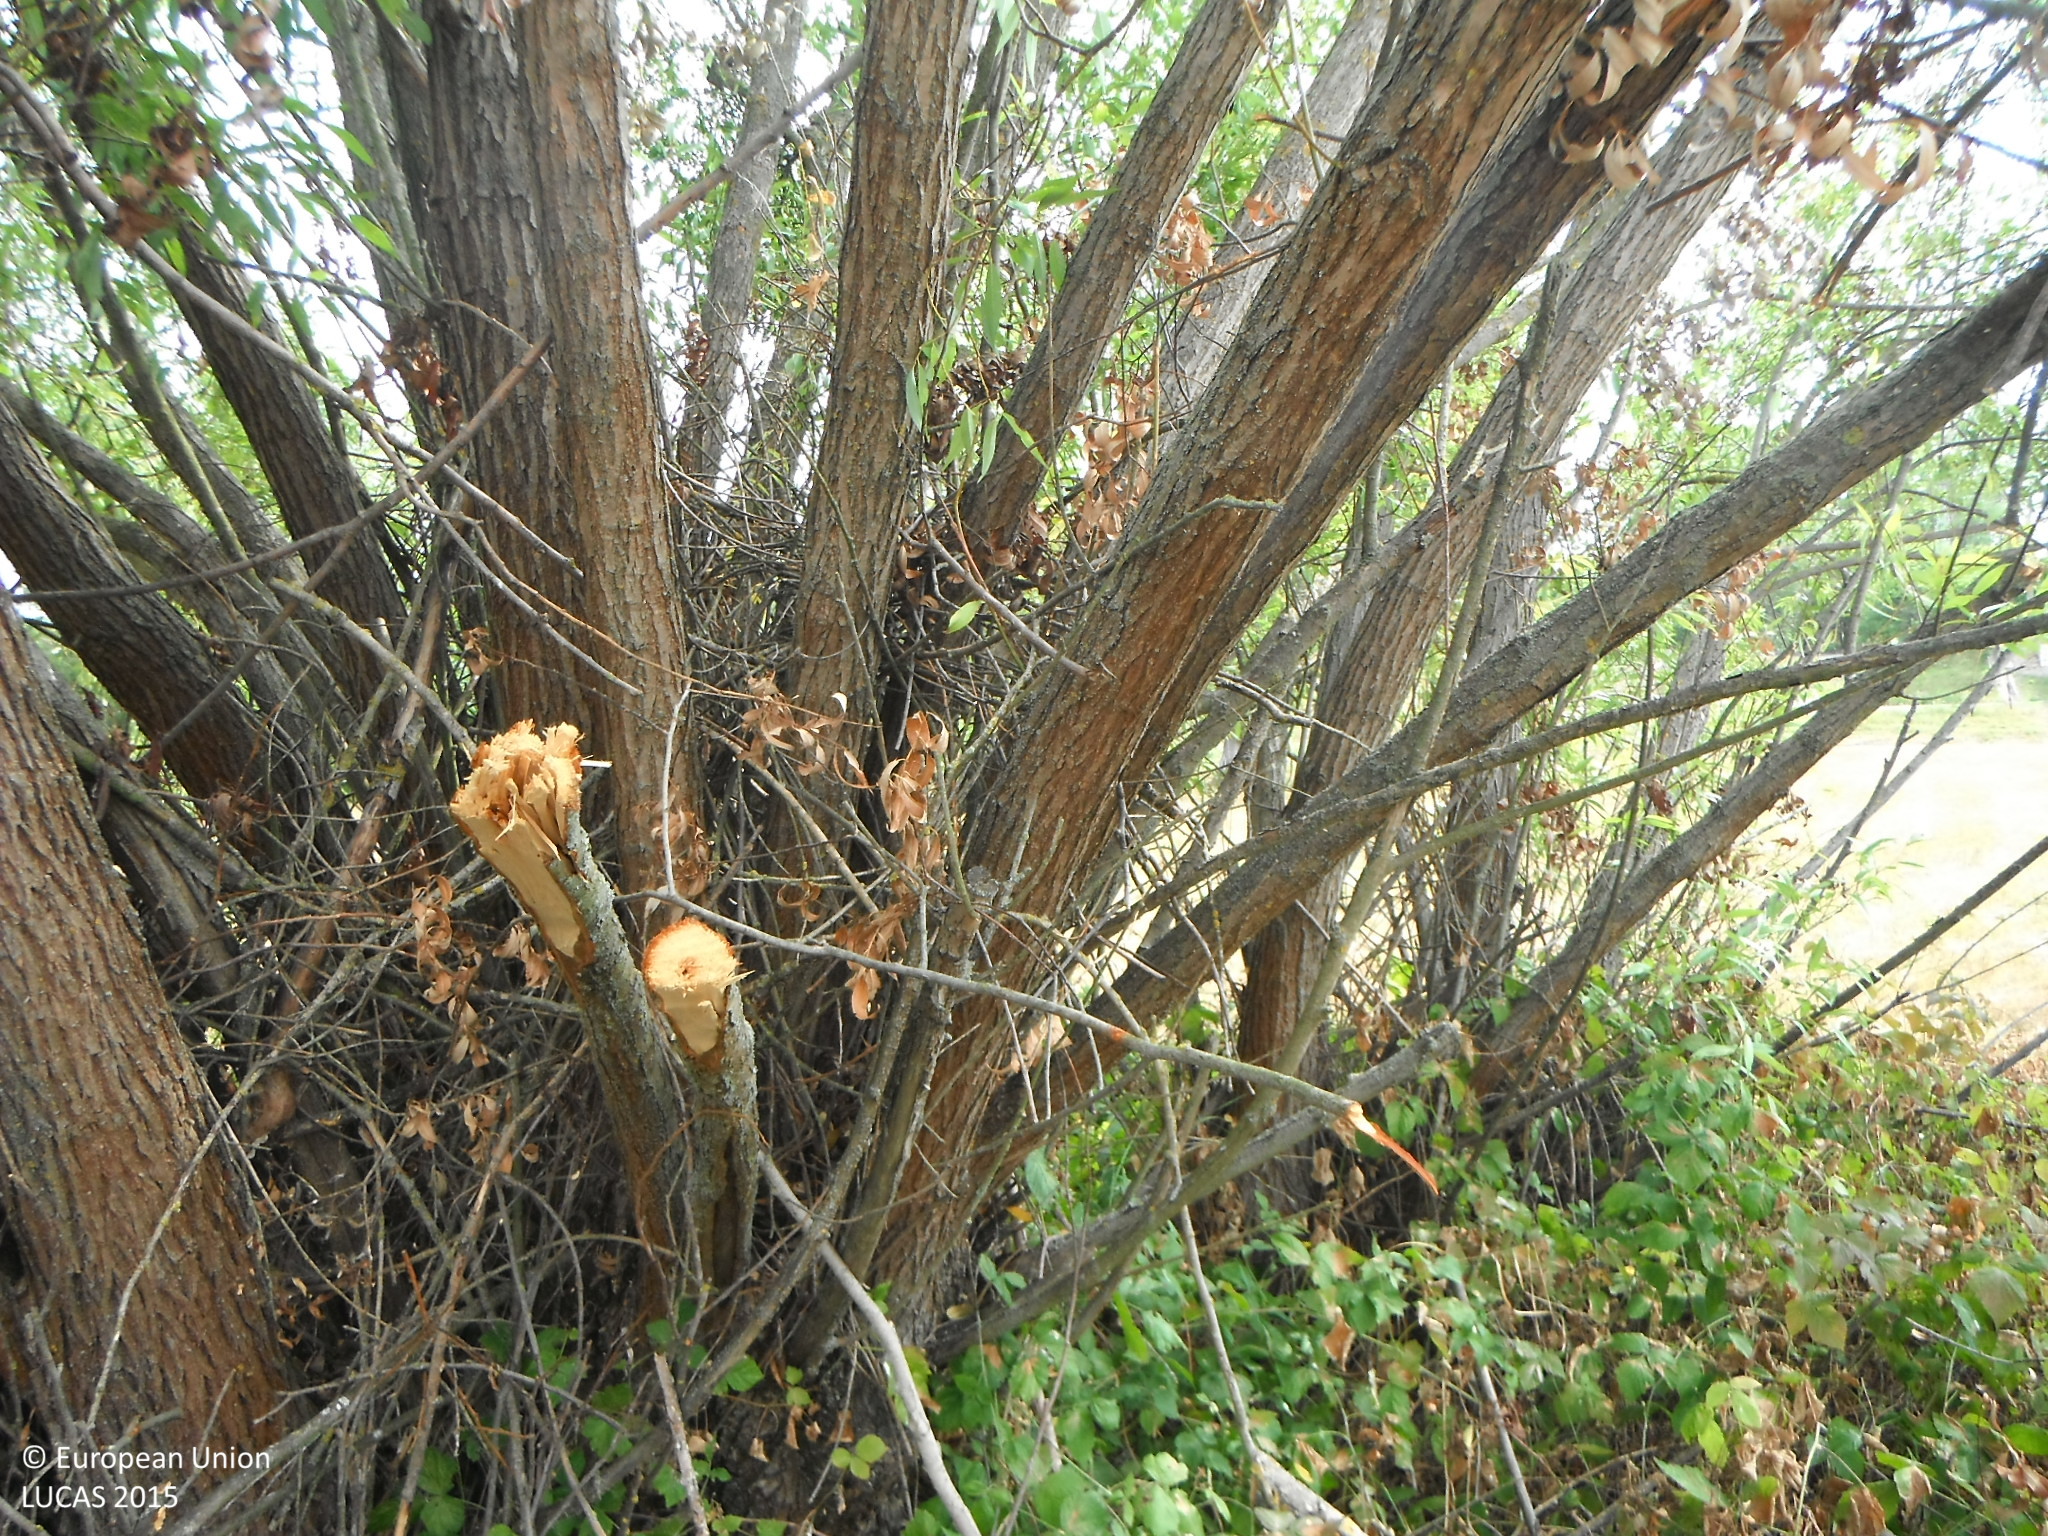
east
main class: Grassland
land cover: Grassland with sparse tree/shrub cover
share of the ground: > 75 %
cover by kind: herbaceous plants 90 %, broadleaved forest trees 5 %, shrubs 5 %
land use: Agriculture (excluding fallow land and kitchen gardens)
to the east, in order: Grassland with sparse tree/shrub cover; Grassland without tree/shrub cover; Broadleaved woodland; Grassland without tree/shrub cover; Ditches and canals; Grassland without tree/shrub cover; Tracks; Grassland without tree/shrub cover; Ditches and canals; Spontaneously vegetated surfaces; Ditches and canals; Spontaneously vegetated surfaces; Broadleaved woodland
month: August
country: SK
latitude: 48.4924
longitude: 21.8378
